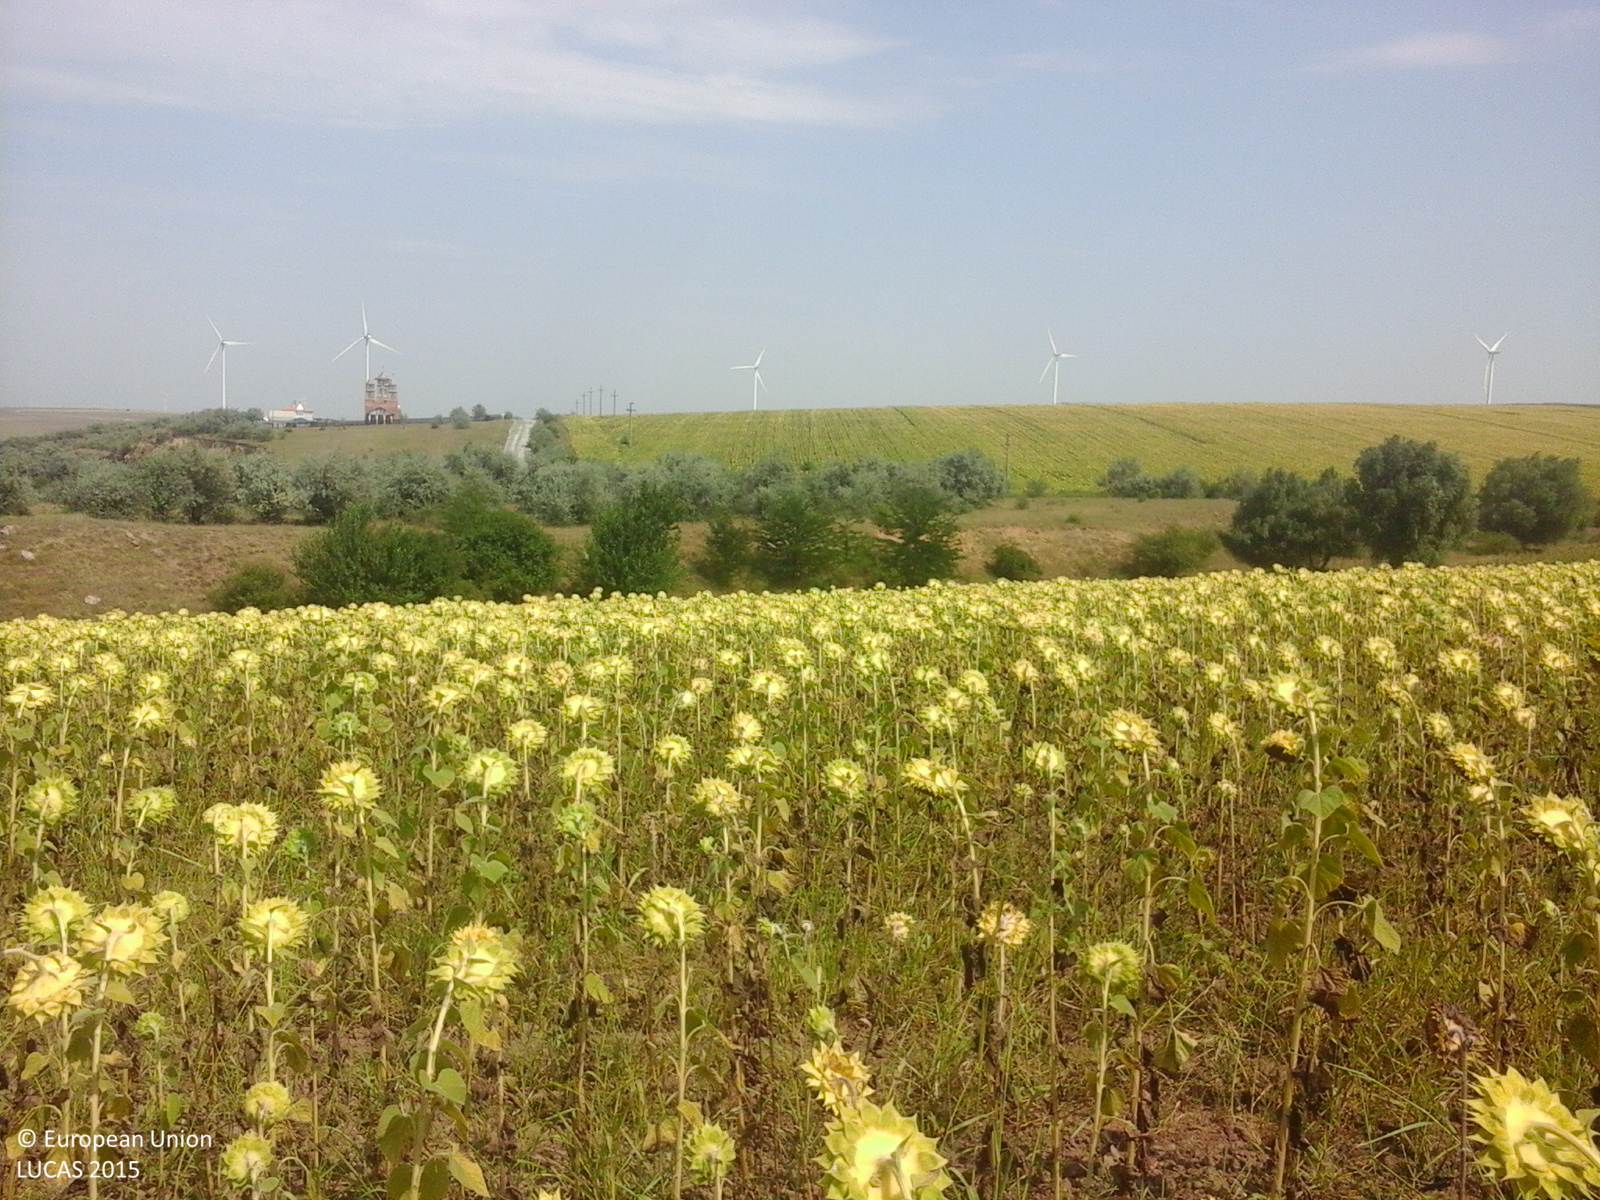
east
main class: Cropland
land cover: Sunflower
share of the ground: > 75 %
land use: Agriculture (excluding fallow land and kitchen gardens)
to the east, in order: Sunflower; Ditches and canals; Grassland with sparse tree/shrub cover; Ditches and canals; Grassland with sparse tree/shrub cover
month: August
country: RO
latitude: 44.3153
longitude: 28.1775
